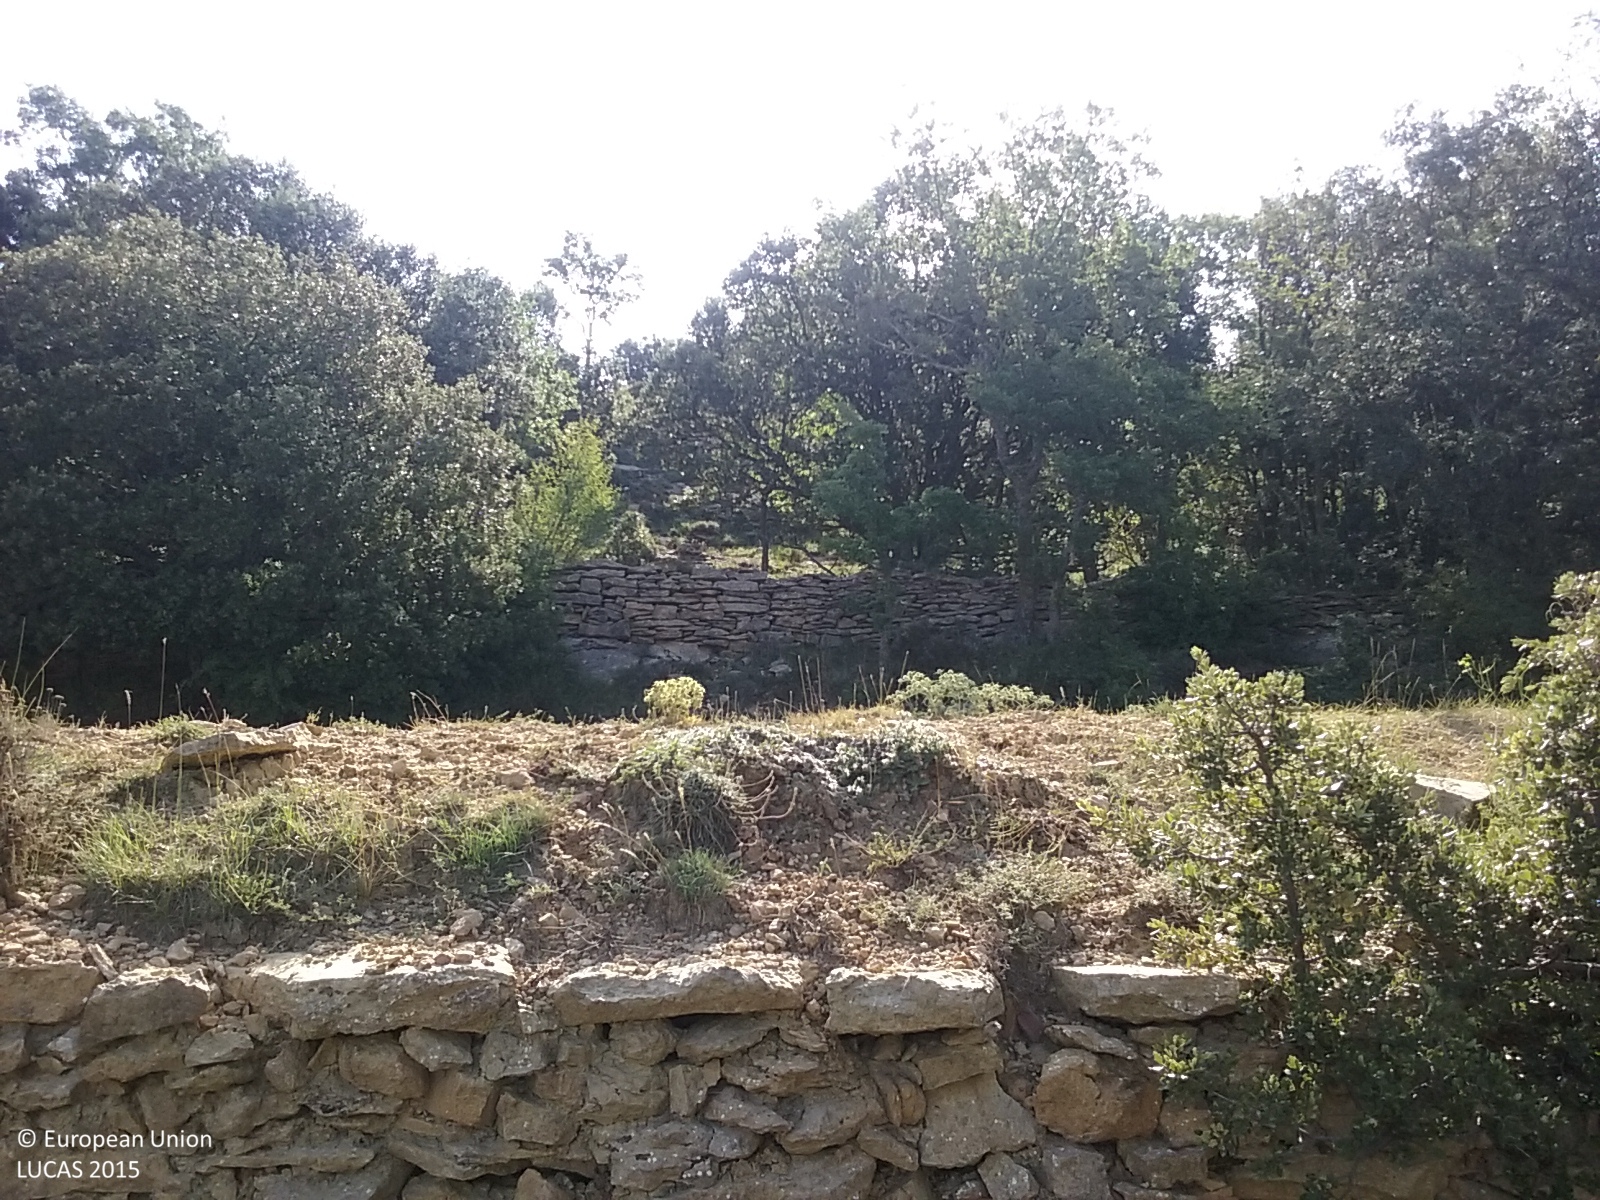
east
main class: Grassland
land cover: Grassland without tree/shrub cover
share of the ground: > 75 %
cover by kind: herbaceous plants 95 %, shrubs 5 %
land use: Agriculture (excluding fallow land and kitchen gardens)
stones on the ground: < 10 %
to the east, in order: Grassland without tree/shrub cover; Dry stone walls; Other bare soil; Groves; Dry stone walls; Broadleaved woodland; Dry stone walls; Grassland with sparse tree/shrub cover; Dry stone walls; Grassland with sparse tree/shrub cover; Broadleaved woodland; Dry stone walls; Grassland without tree/shrub cover
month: August
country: ES
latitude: 40.4624
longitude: -0.2075
